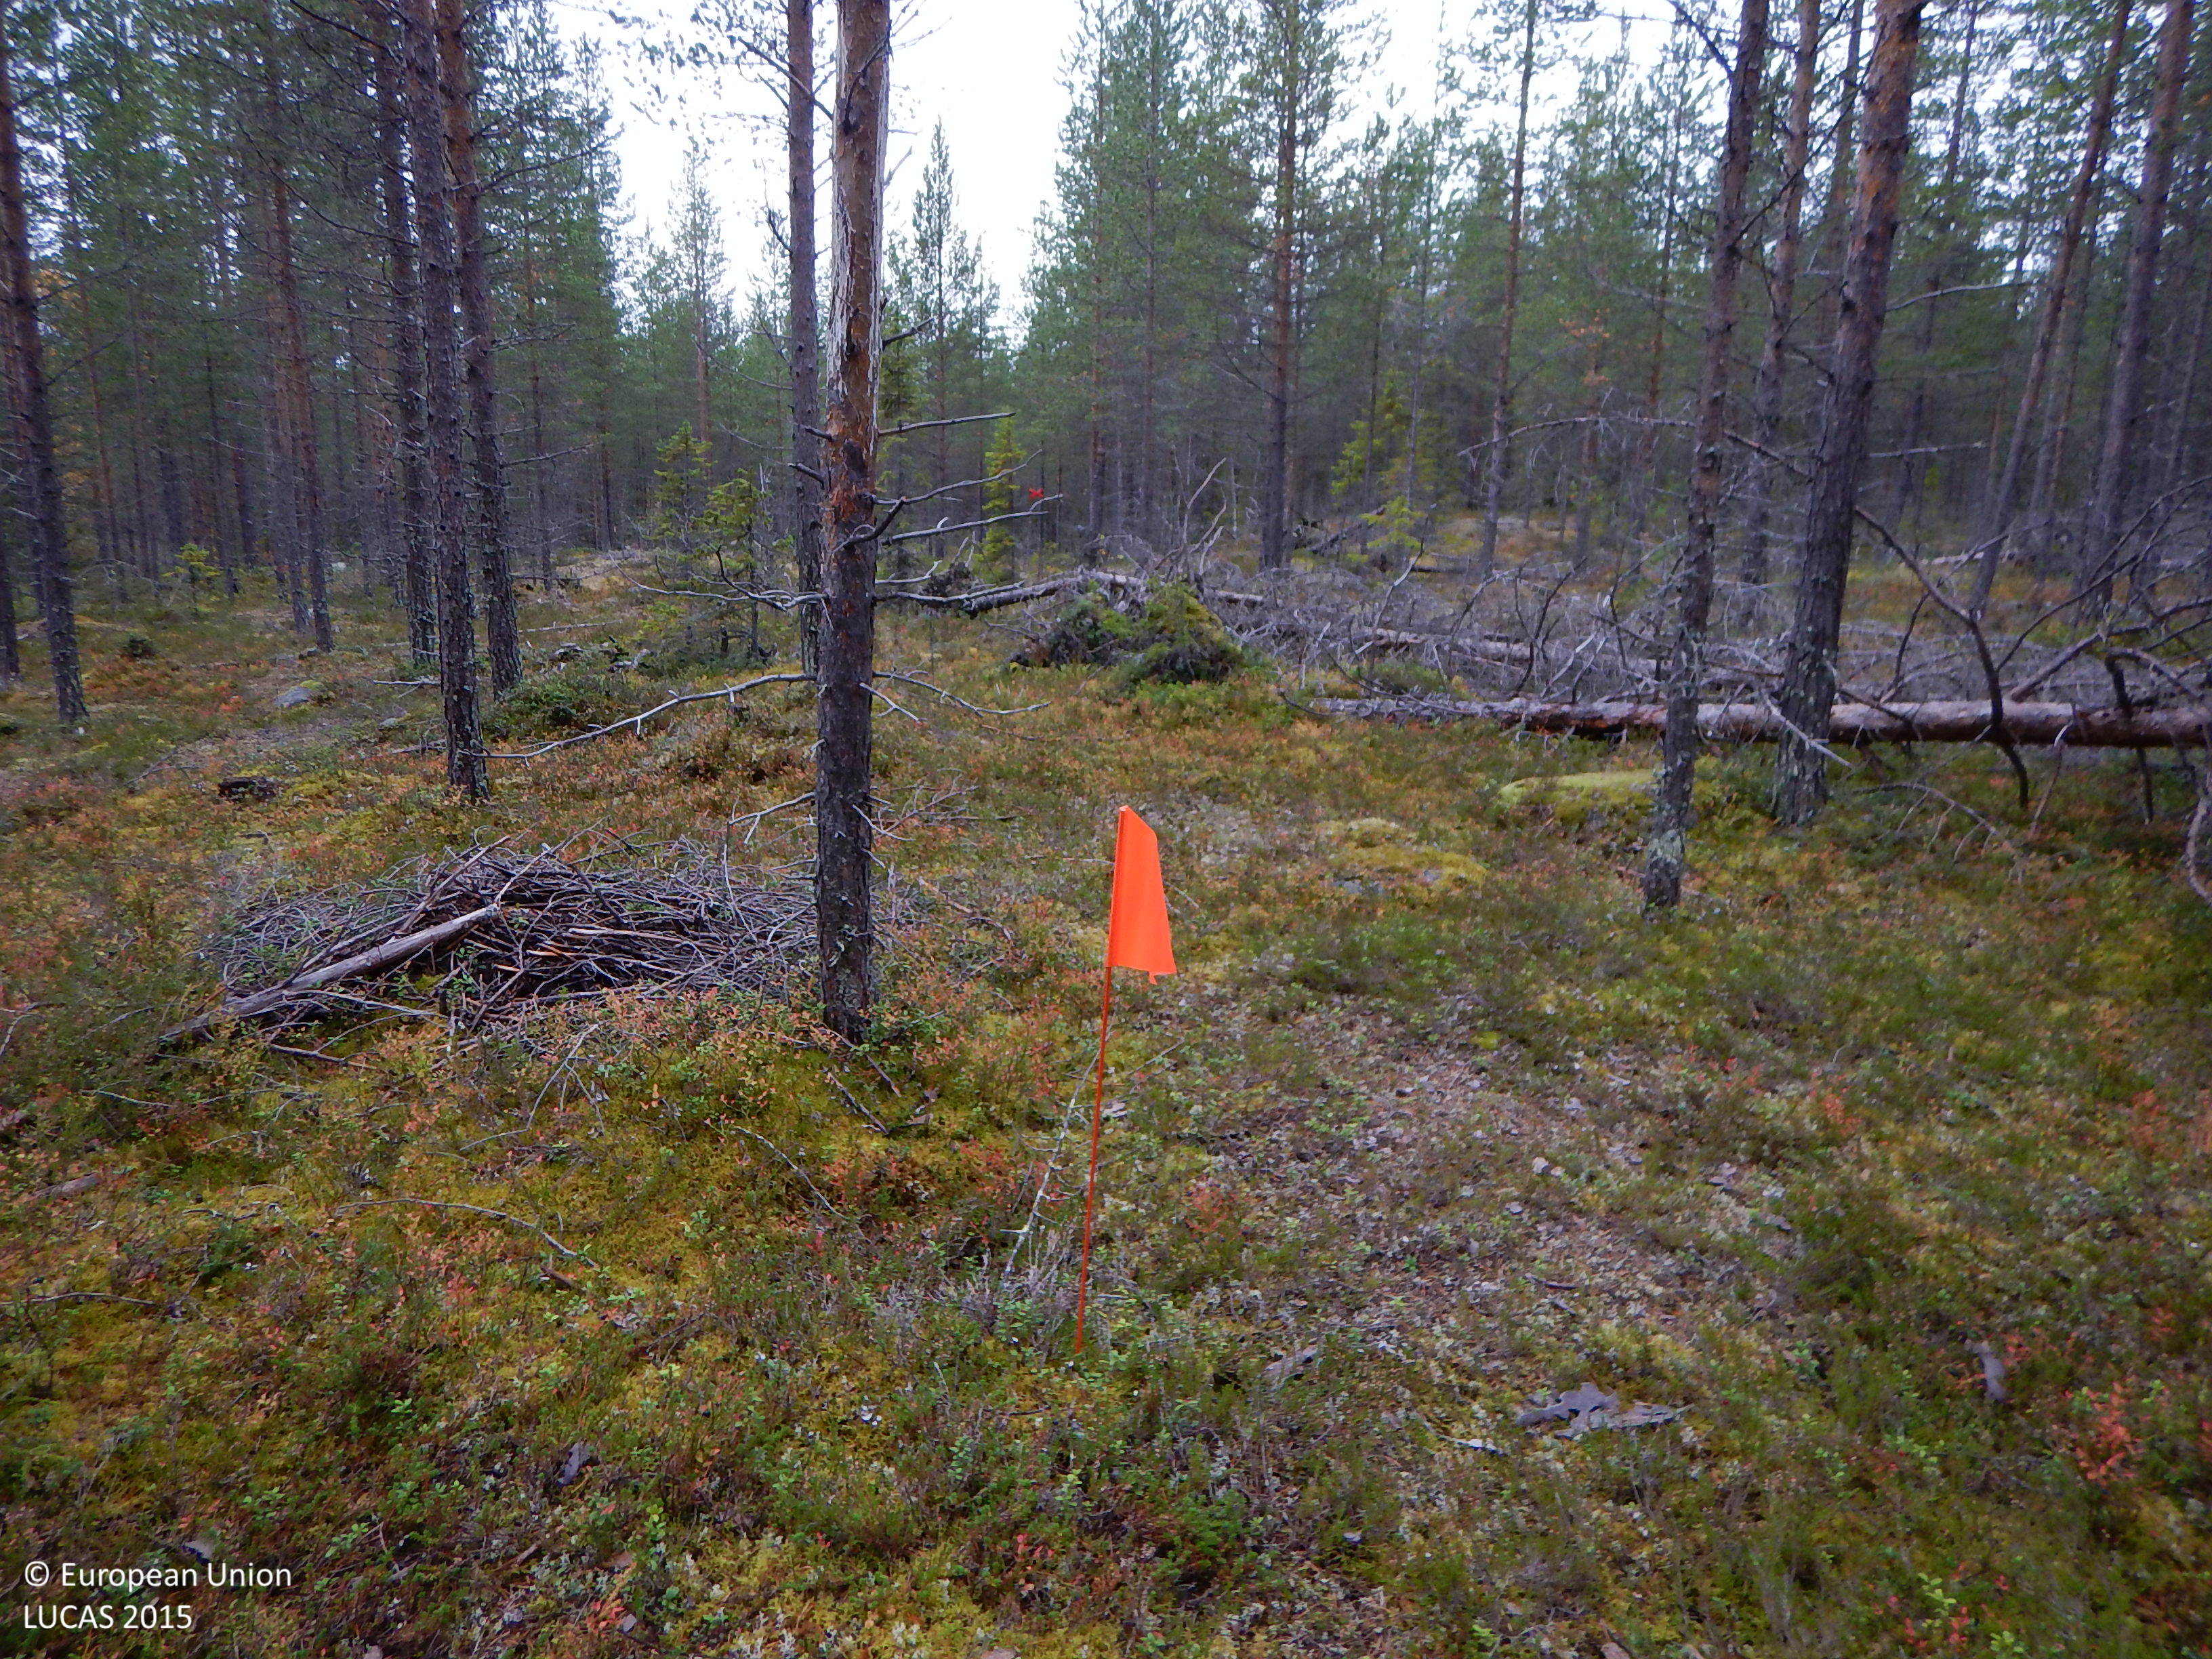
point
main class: Woodland
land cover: Pine dominated coniferous woodland
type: boreal forest
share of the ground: 50 - 75 %
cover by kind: coniferous forest trees 65 %, shrubs 15 %, lichens and mosses 15 %, herbaceous plants 5 %
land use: Forestry
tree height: > 5 m
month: September
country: SE
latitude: 65.0743
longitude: 19.2586
